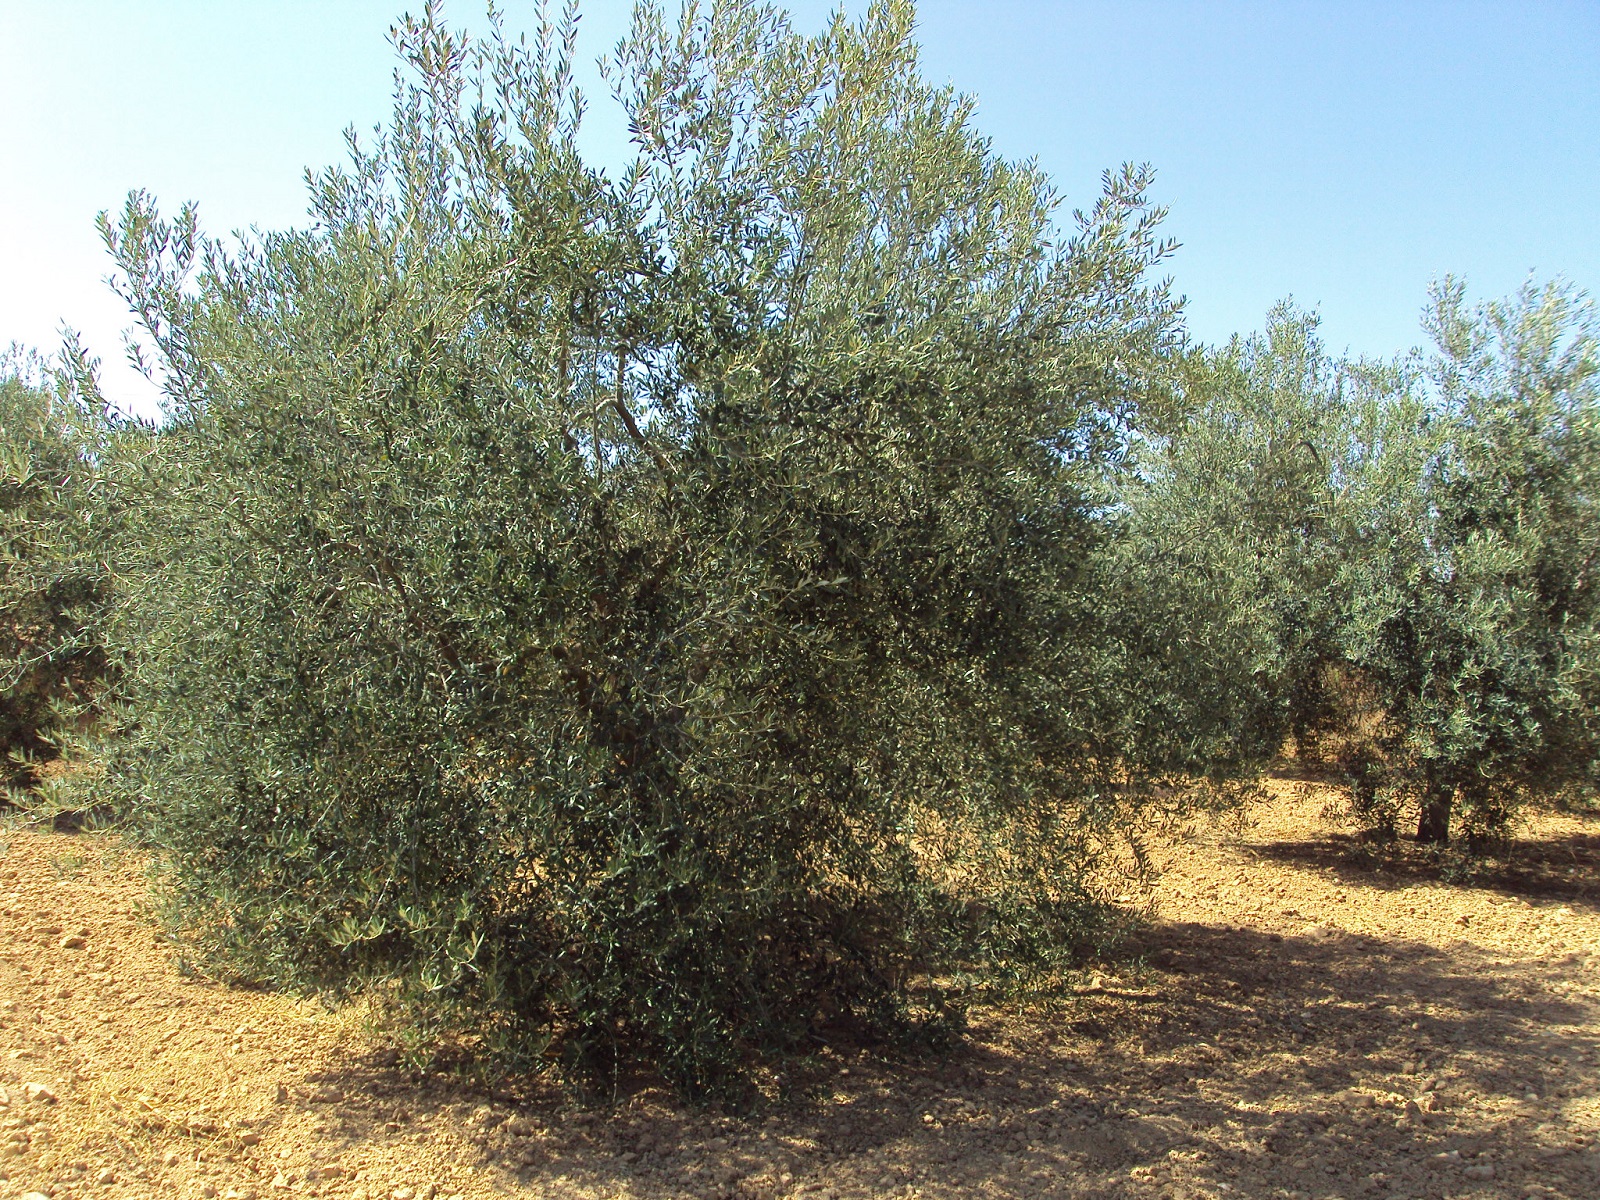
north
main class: Cropland
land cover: Olive groves
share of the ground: 50 - 75 %
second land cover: Other bare soil
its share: > 75 %
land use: Agriculture (excluding fallow land and kitchen gardens)
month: June
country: ES
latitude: 37.2923
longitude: -6.6033
